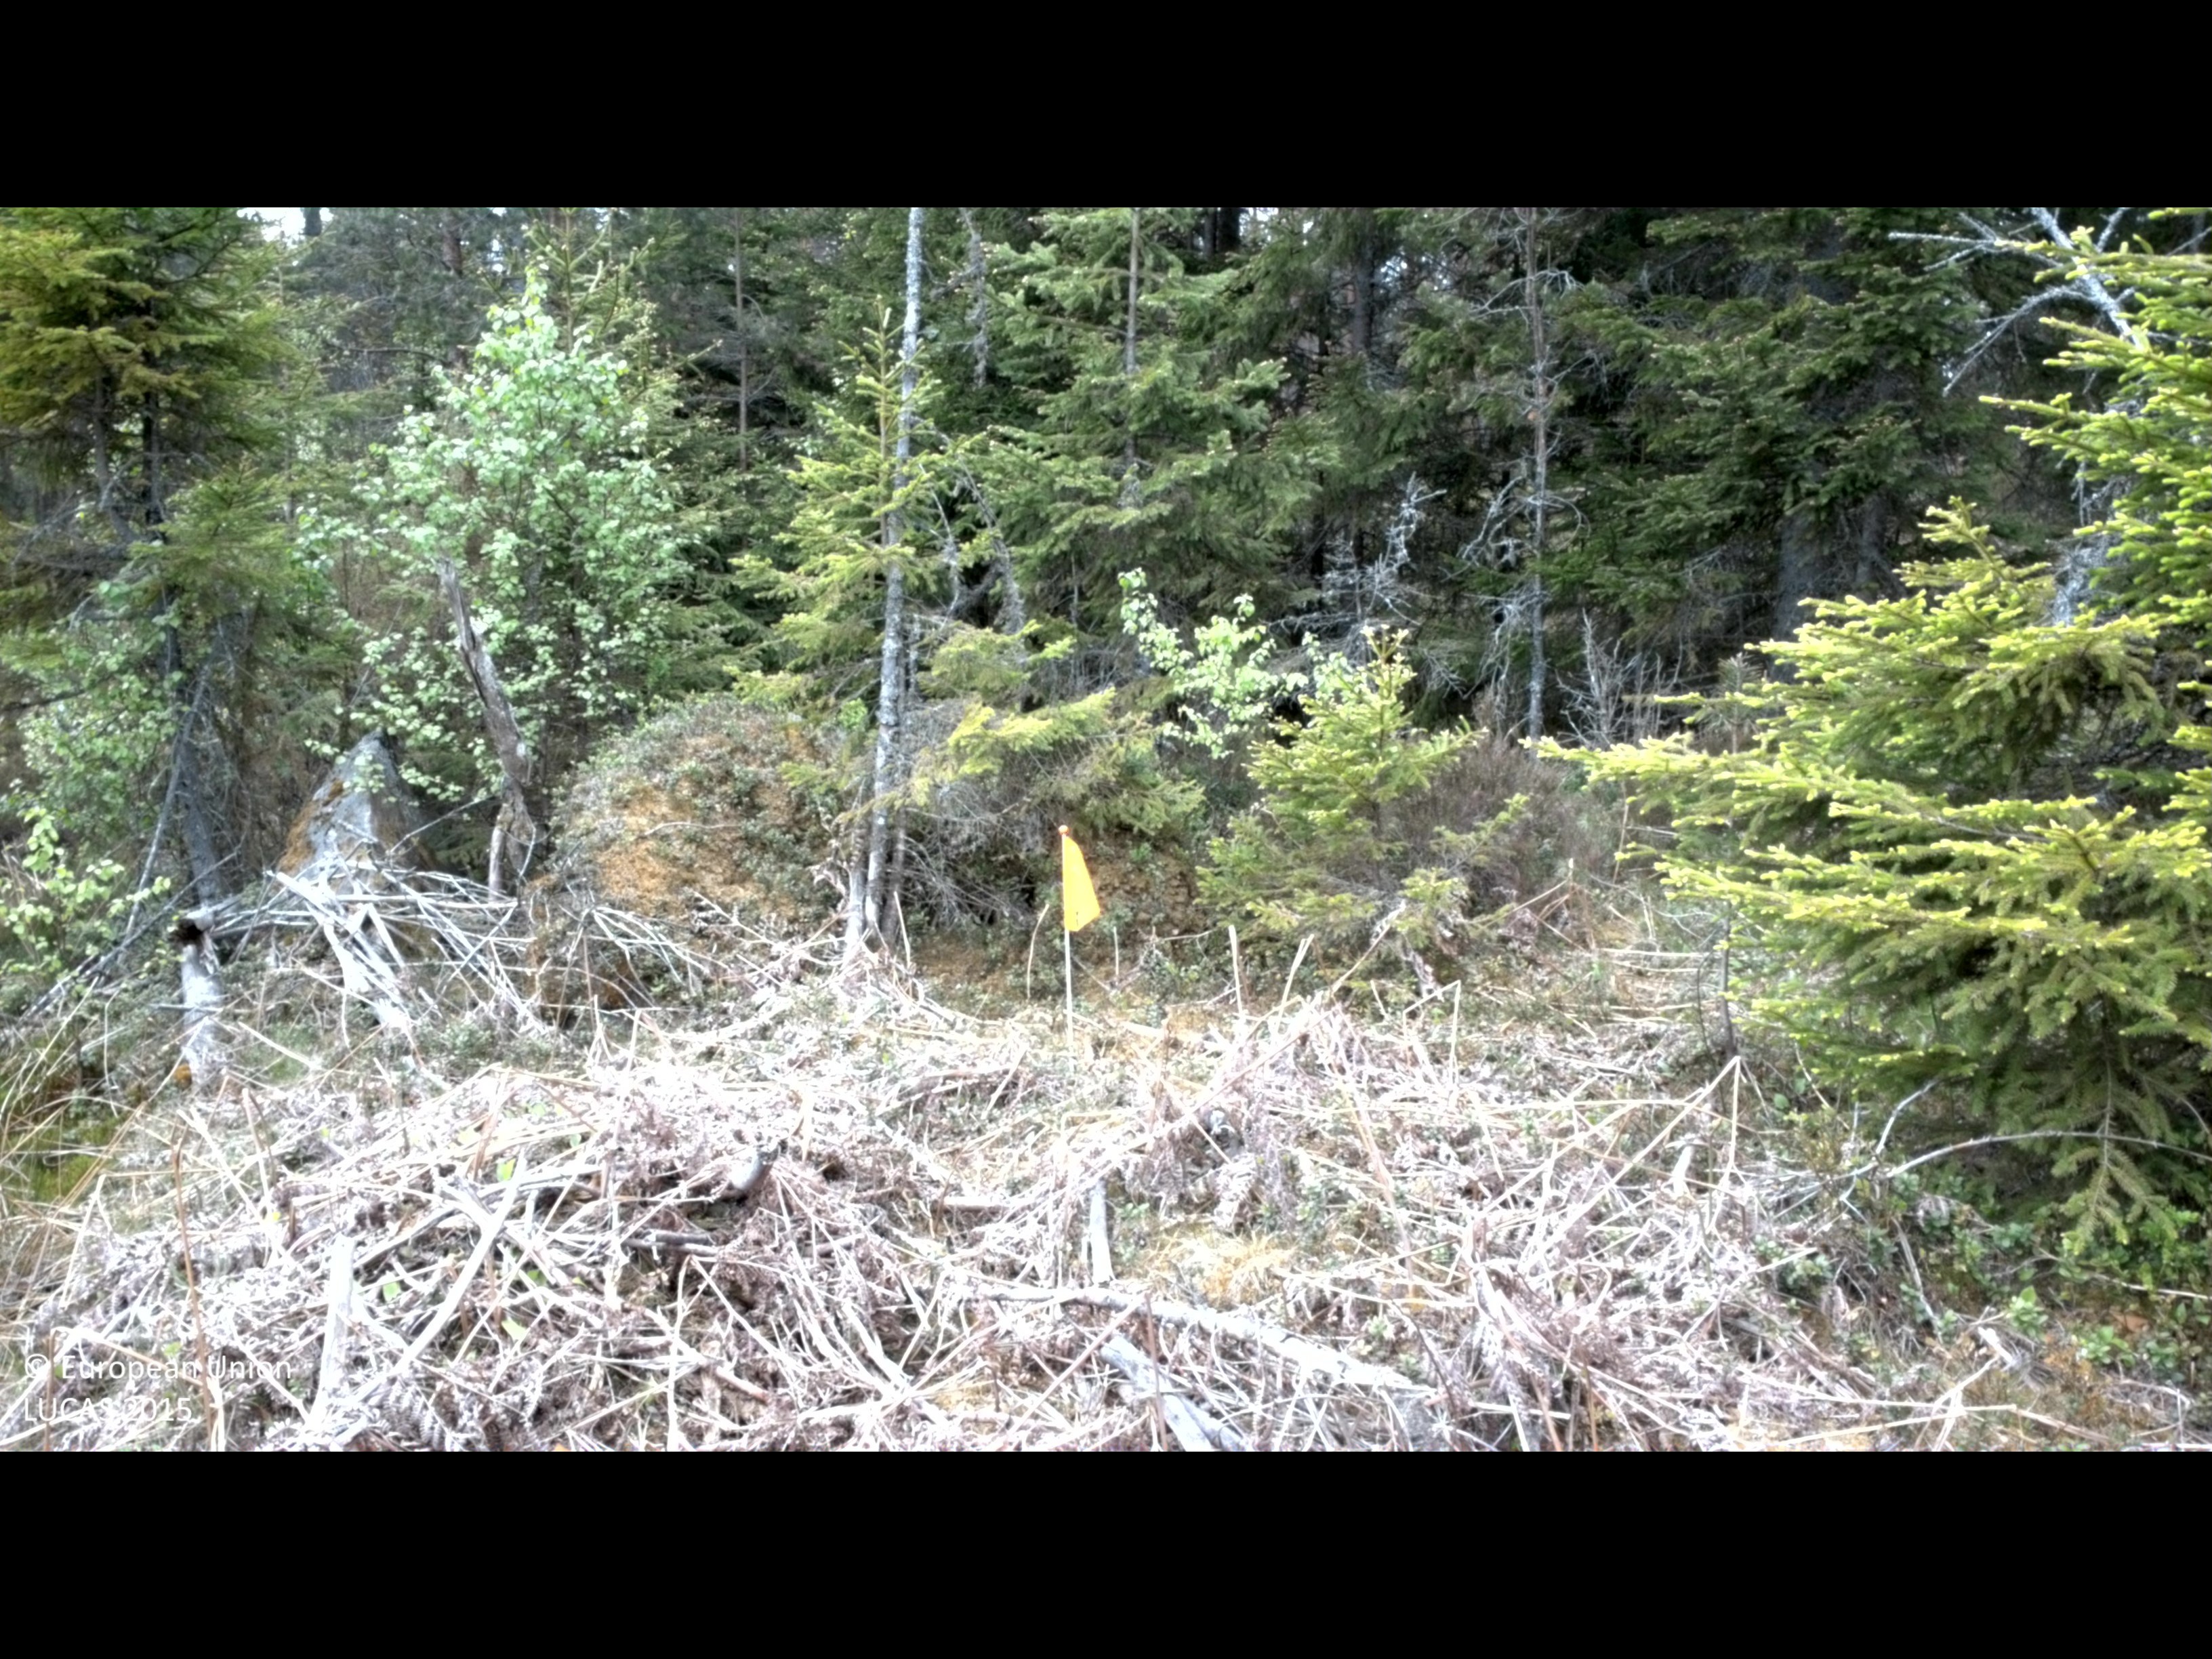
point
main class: Woodland
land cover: Spruce dominated coniferous woodland
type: boreal forest
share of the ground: > 75 %
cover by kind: coniferous forest trees 60 %, broadleaved forest trees 20 %, shrubs 20 %
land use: Forestry
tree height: < 5 m
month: May
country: SE
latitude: 57.4177
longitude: 16.0086
